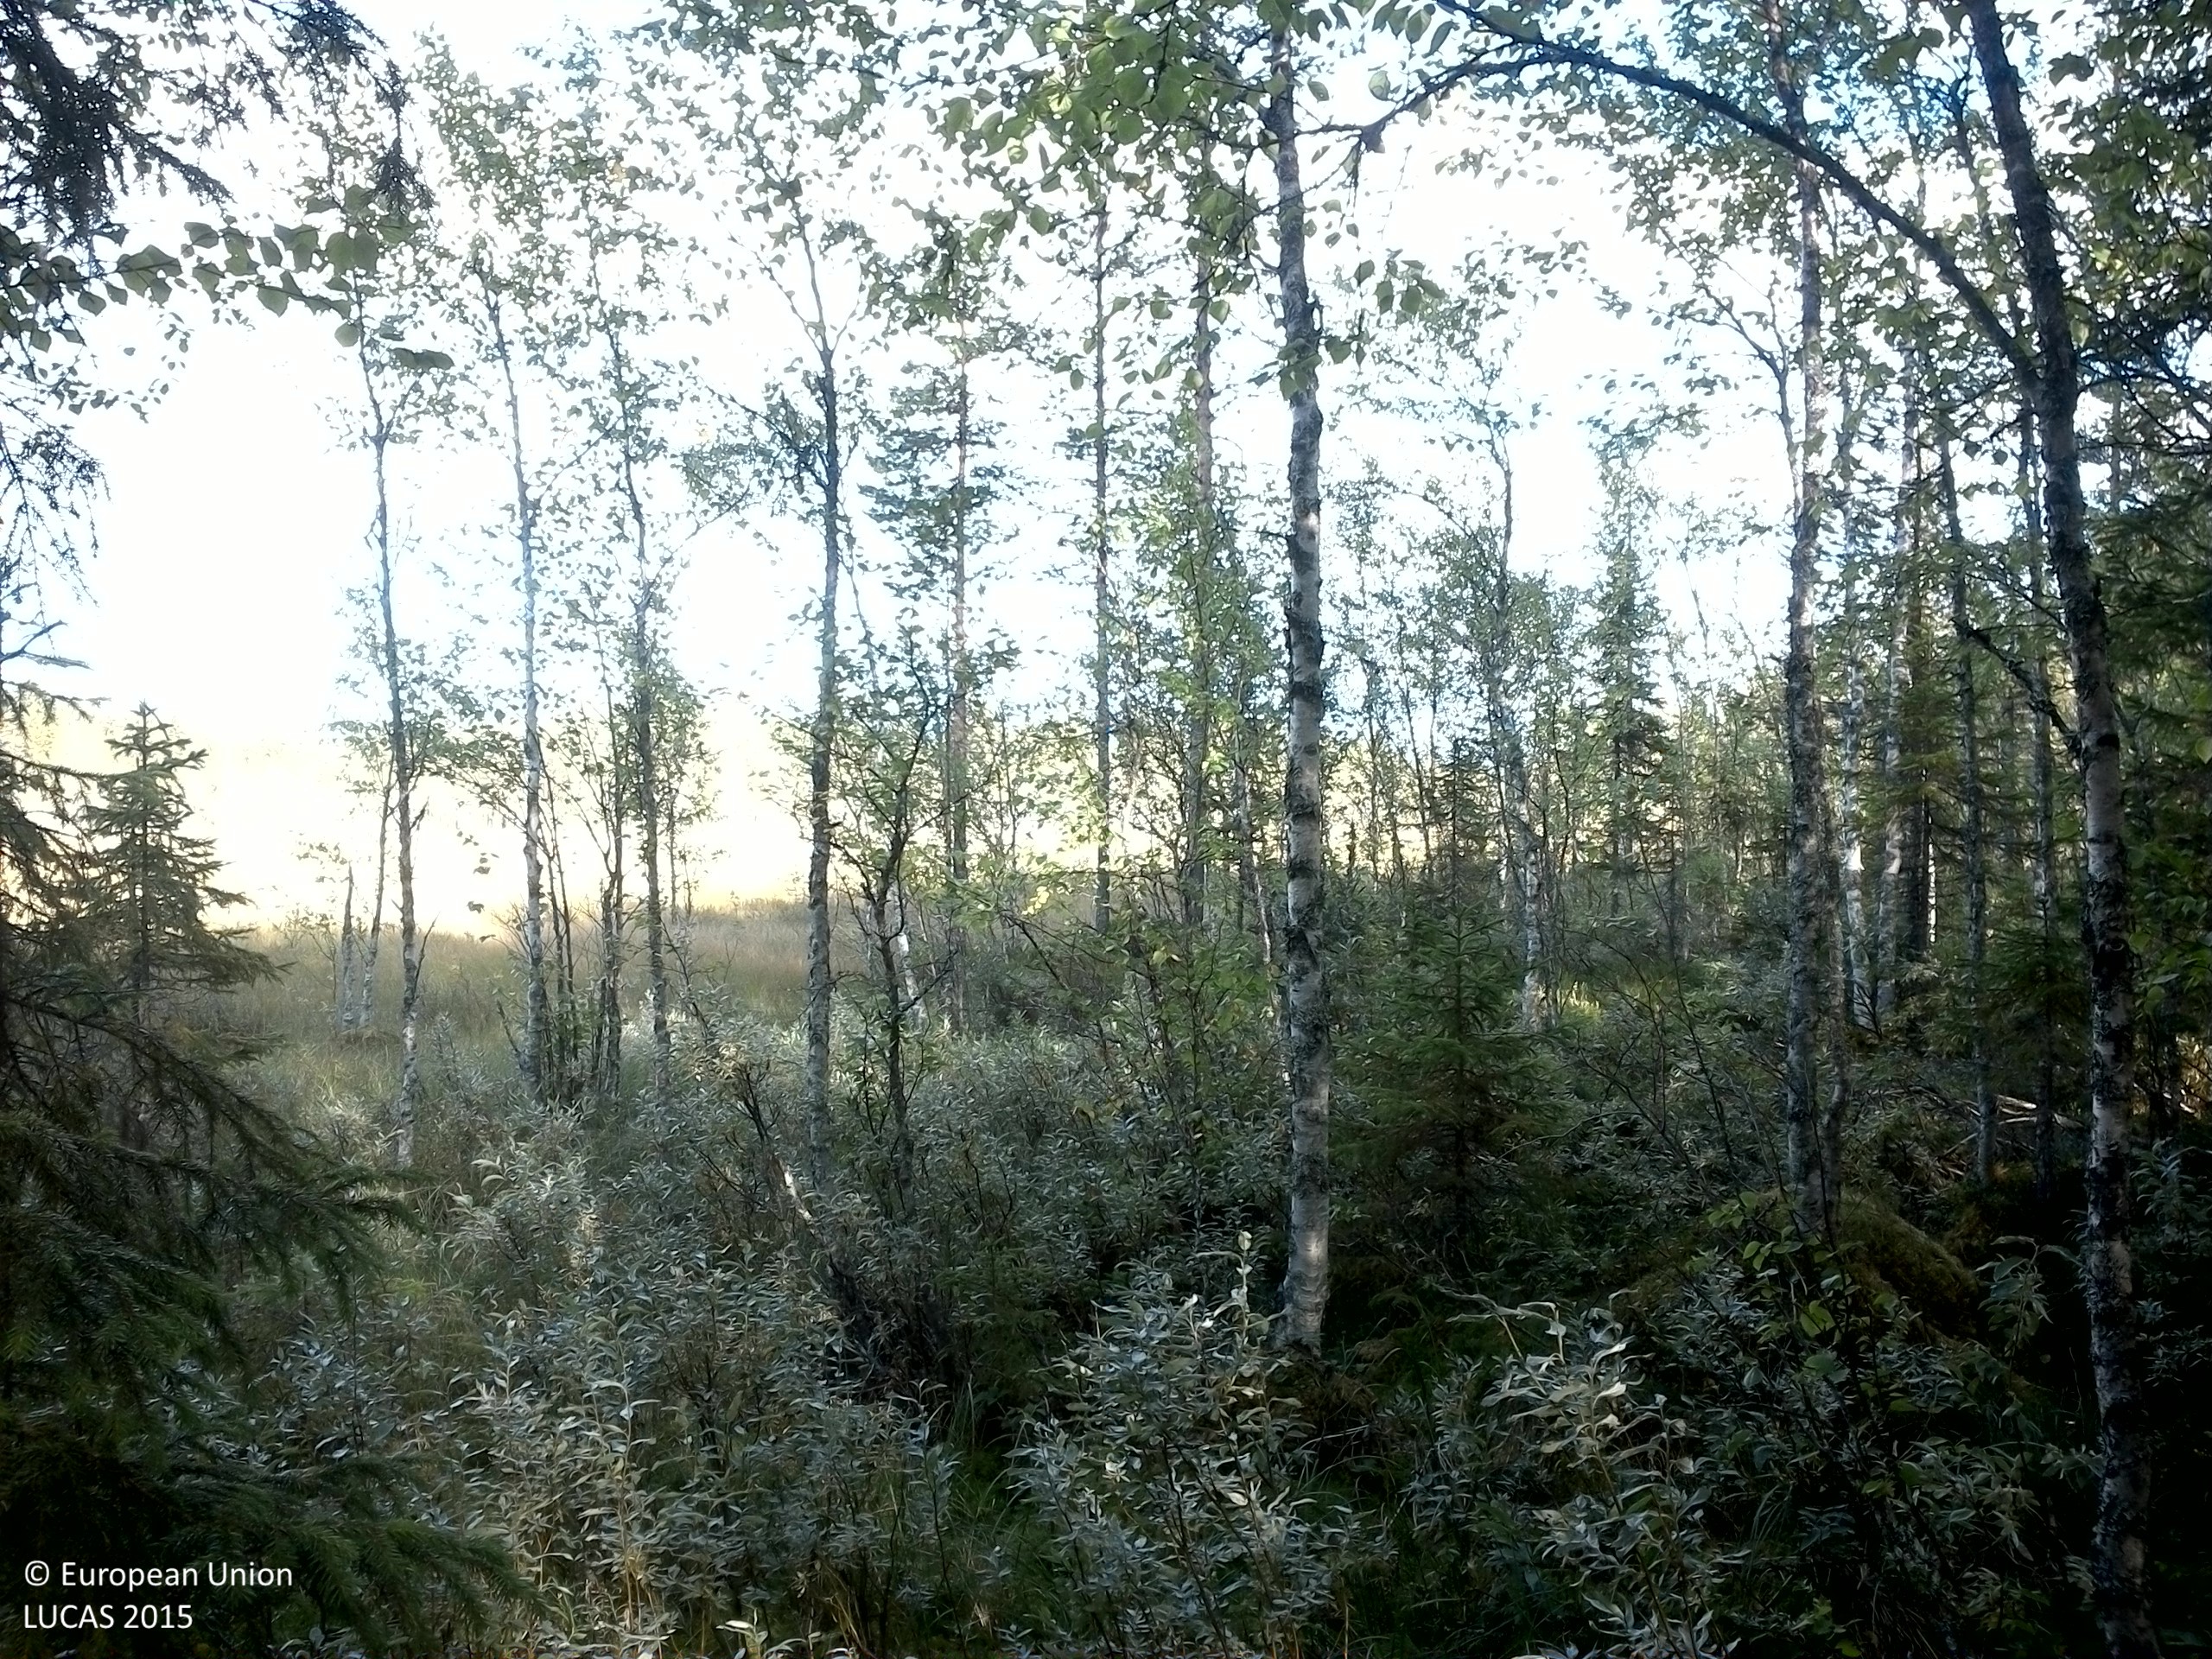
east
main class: Woodland
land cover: Pine dominated mixed woodland
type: boreal forest
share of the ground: > 75 %
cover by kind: coniferous forest trees 50 %, broadleaved forest trees 25 %, shrubs 15 %, lichens and mosses 10 %
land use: Forestry
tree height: > 5 m
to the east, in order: Pine dominated mixed woodland; Peatbogs; Pine dominated coniferous woodland; Peatbogs; Pine dominated mixed woodland
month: August
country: SE
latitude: 64.0891
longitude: 17.2104
